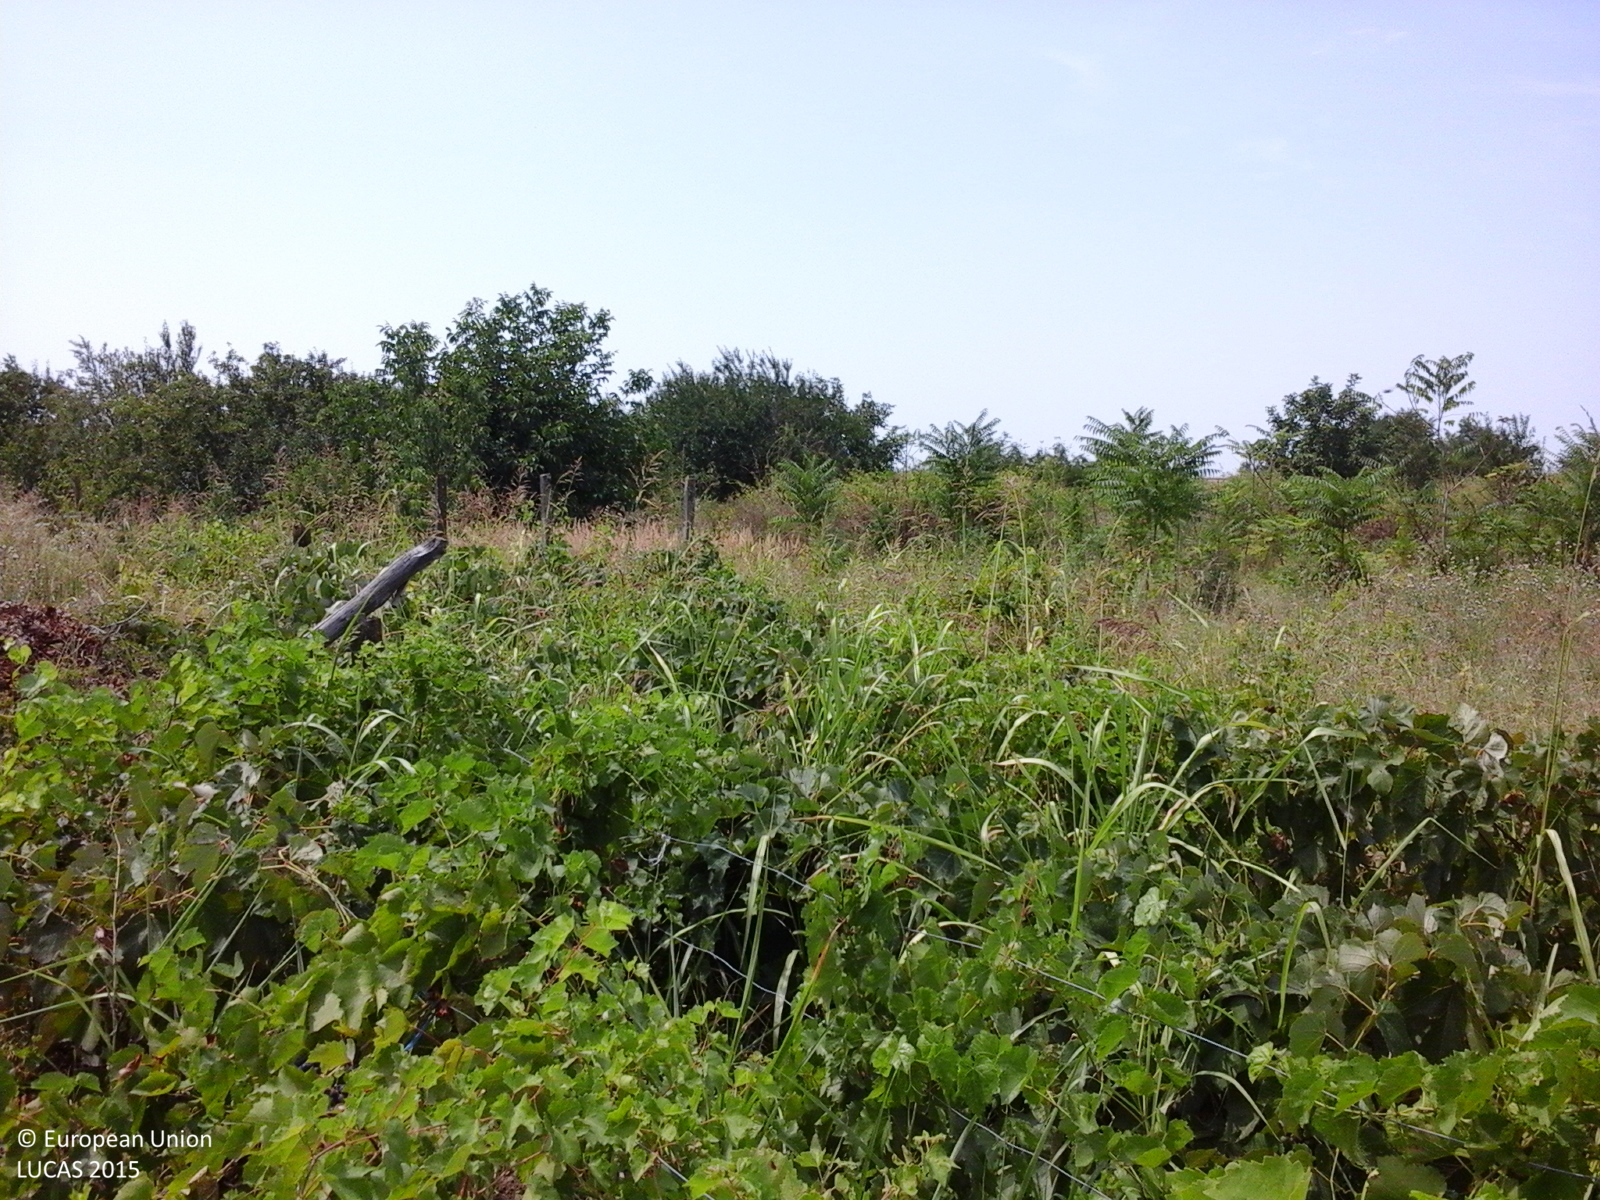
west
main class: Cropland
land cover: Vineyards
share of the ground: > 75 %
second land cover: Grassland without tree/shrub cover
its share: < 10 %
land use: Agriculture (excluding fallow land and kitchen gardens)
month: August
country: RO
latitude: 44.2182
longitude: 23.1760
